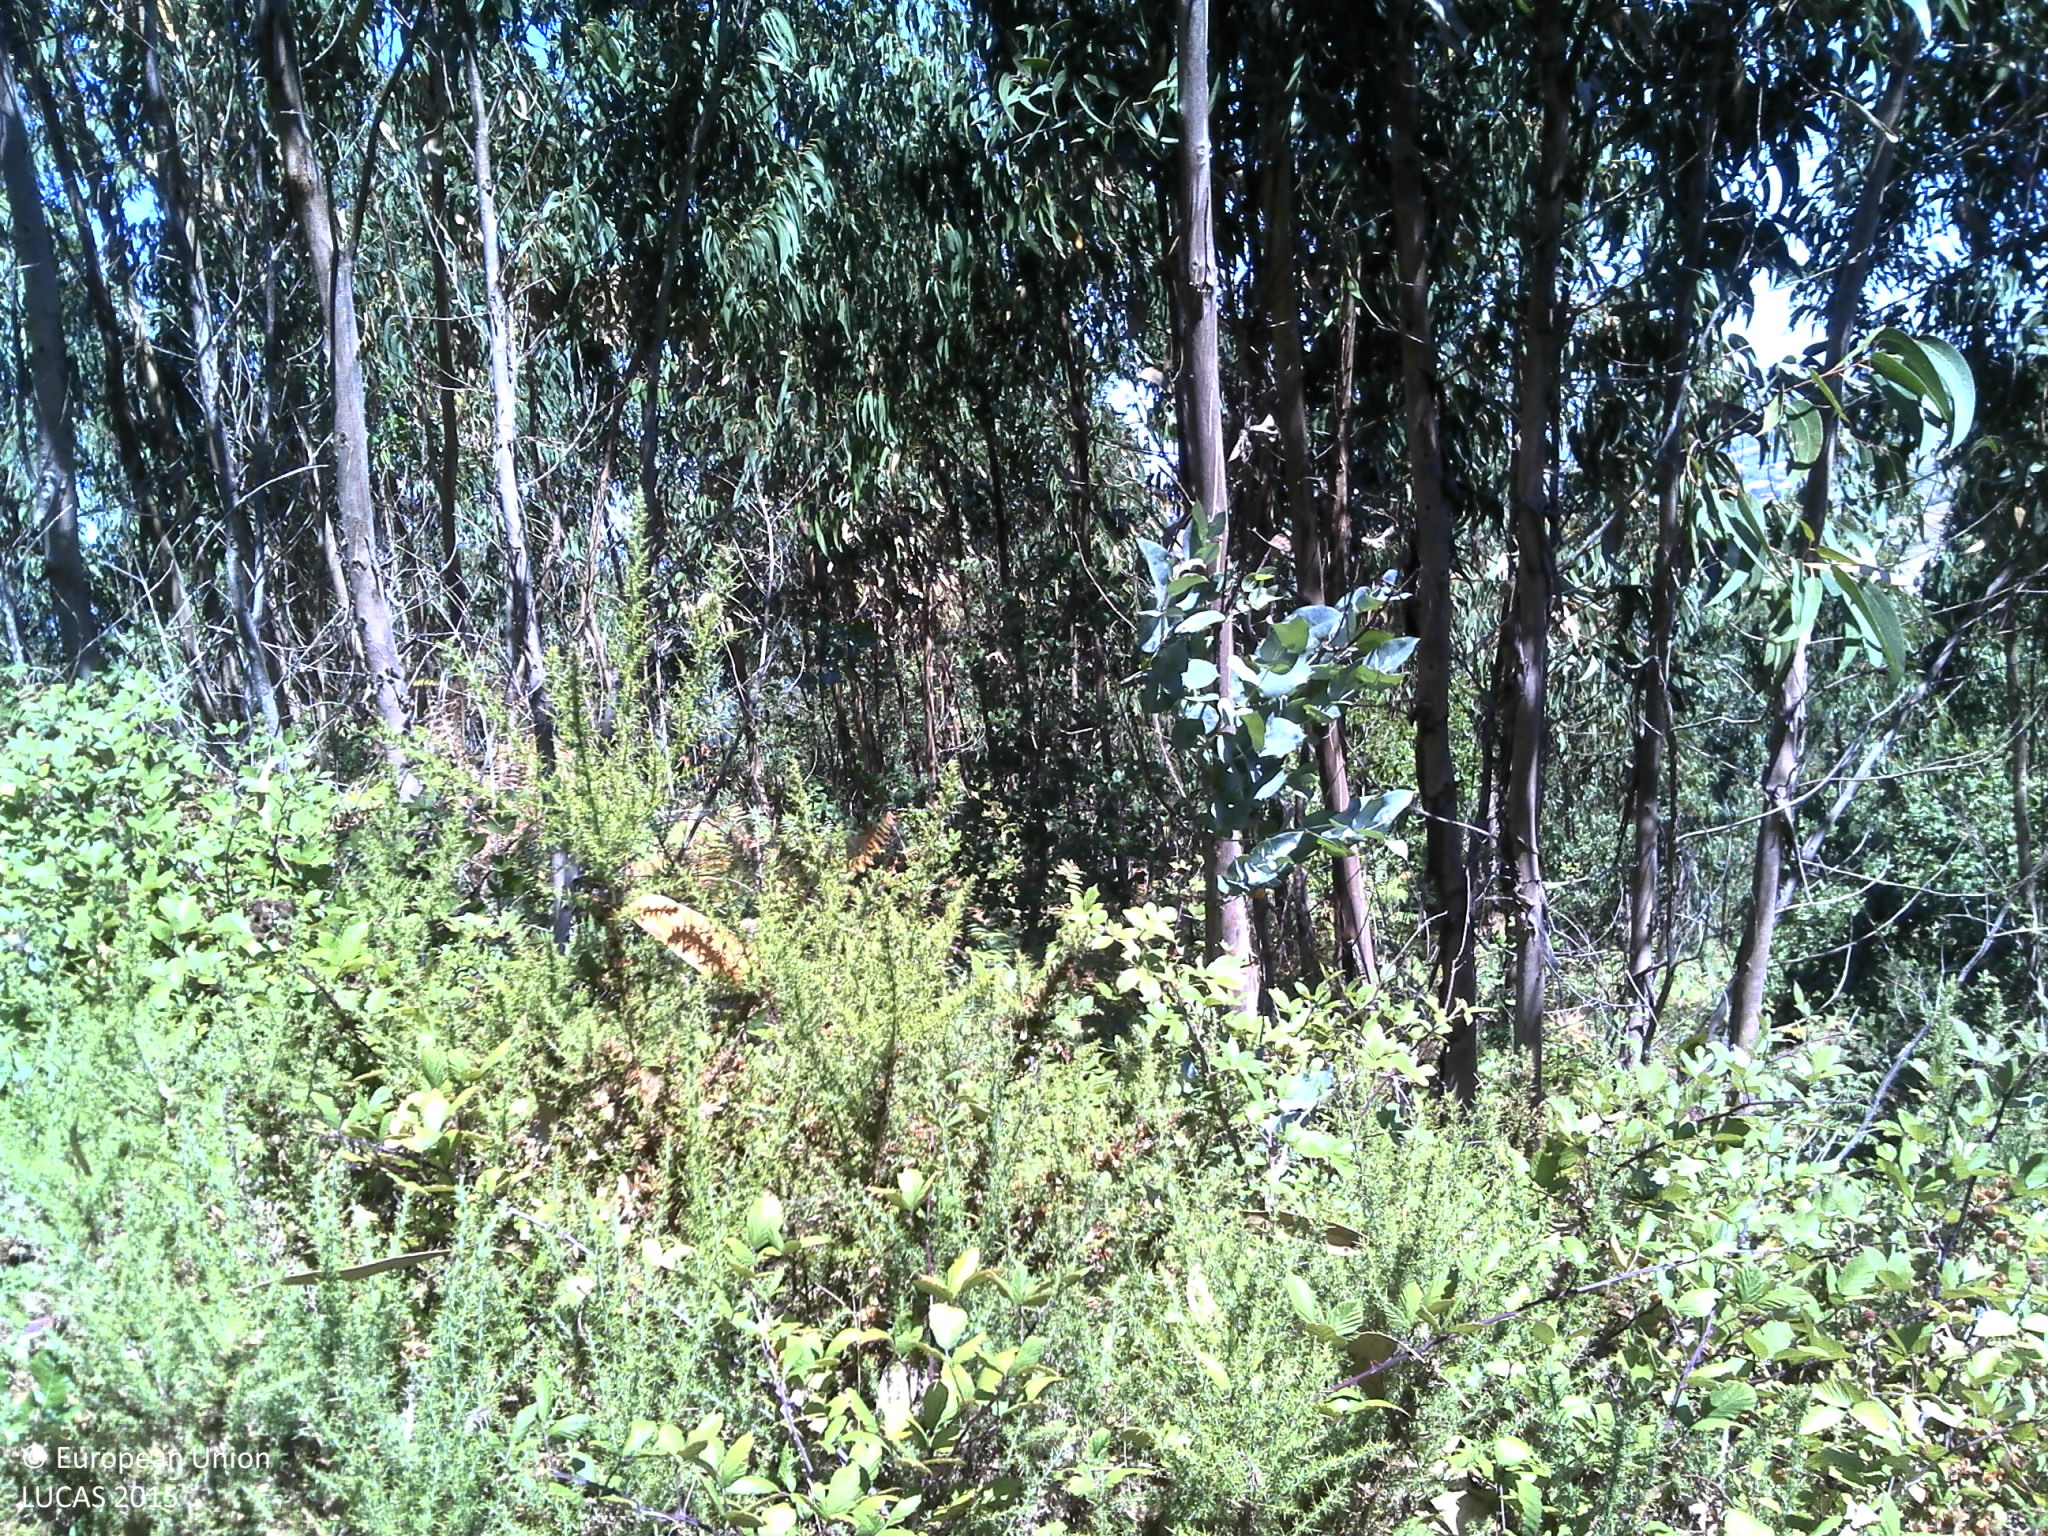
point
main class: Woodland
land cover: Broadleaved woodland
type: exotic forest
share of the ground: 50 - 75 %
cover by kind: broadleaved forest trees 55 %, shrubs 30 %, unconsolidated bare surface 15 %
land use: Forestry
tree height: > 5 m
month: July
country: PT
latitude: 38.9524
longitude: -9.2494
